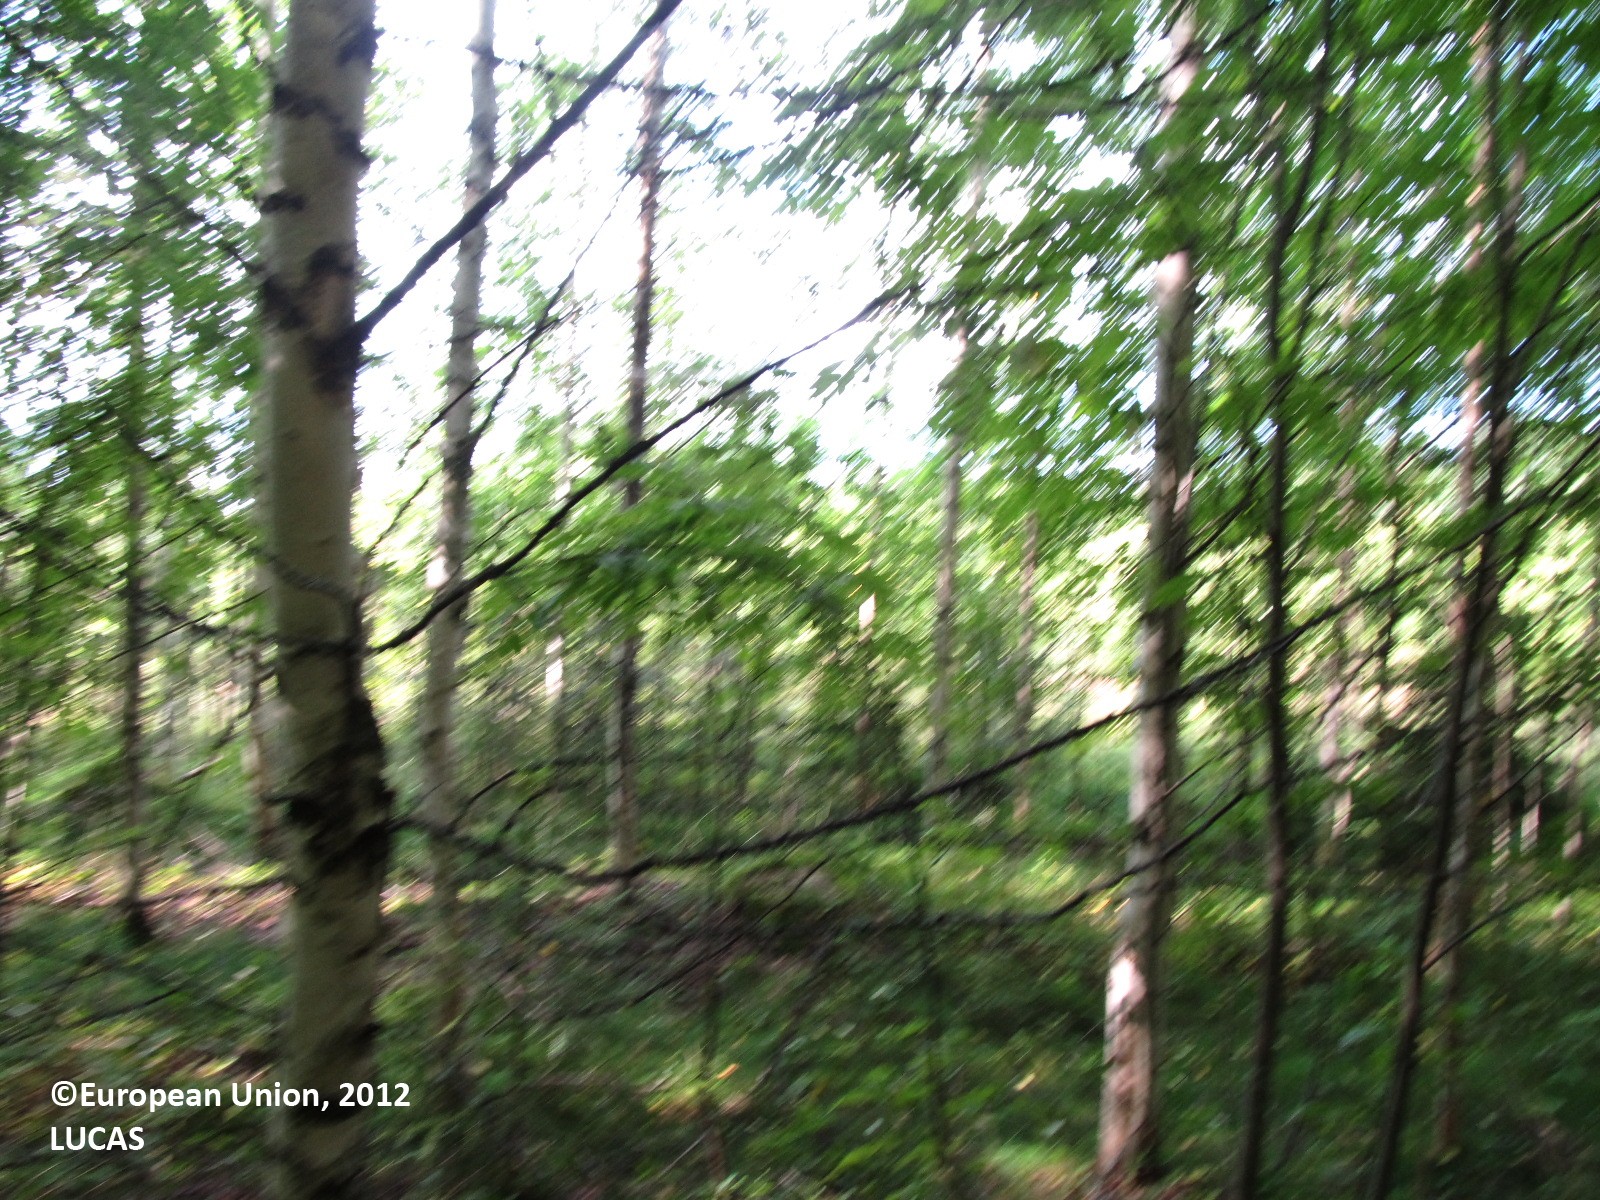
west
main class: Woodland
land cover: Broadleaved woodland
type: boreal forest
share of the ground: 25 - 50 %
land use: Forestry
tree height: > 5 m
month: July
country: FI
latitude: 62.0558
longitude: 28.1162
